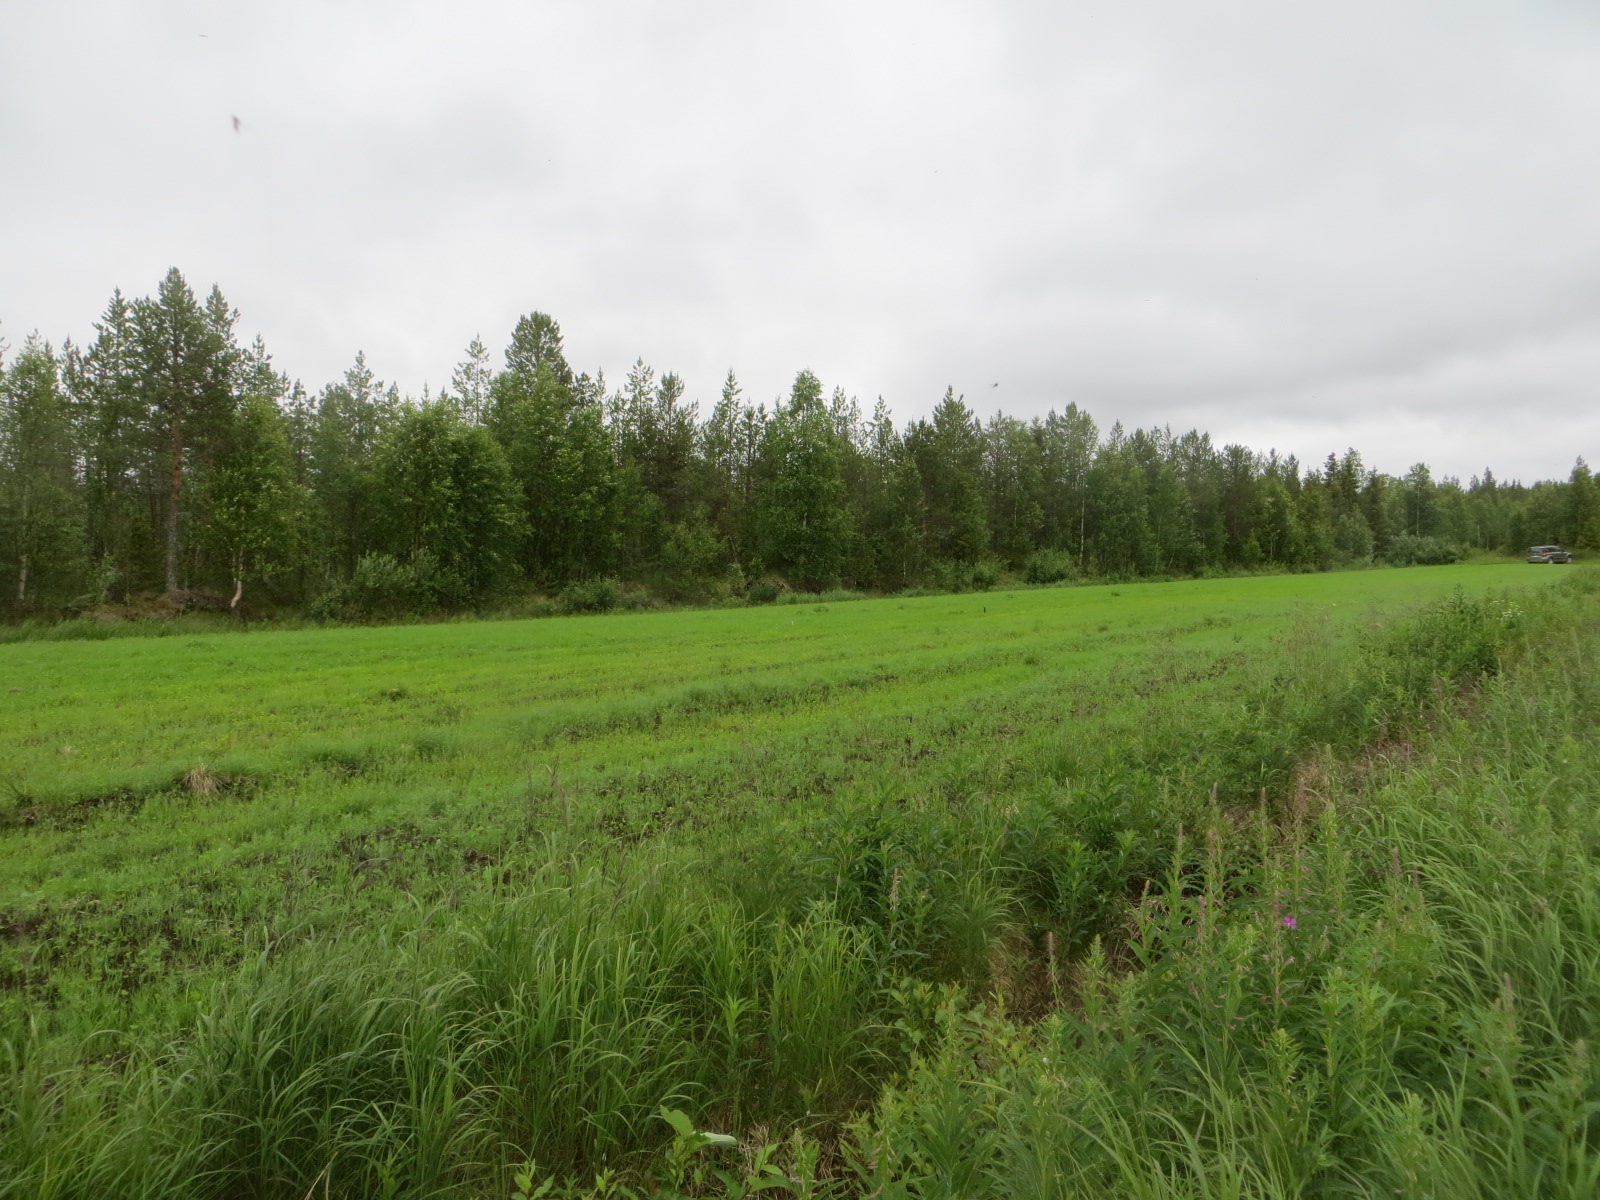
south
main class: Cropland
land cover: Temporary grasslands
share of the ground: 25 - 50 %
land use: Agriculture (excluding fallow land and kitchen gardens)
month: July
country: FI
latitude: 66.3943
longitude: 24.3892
